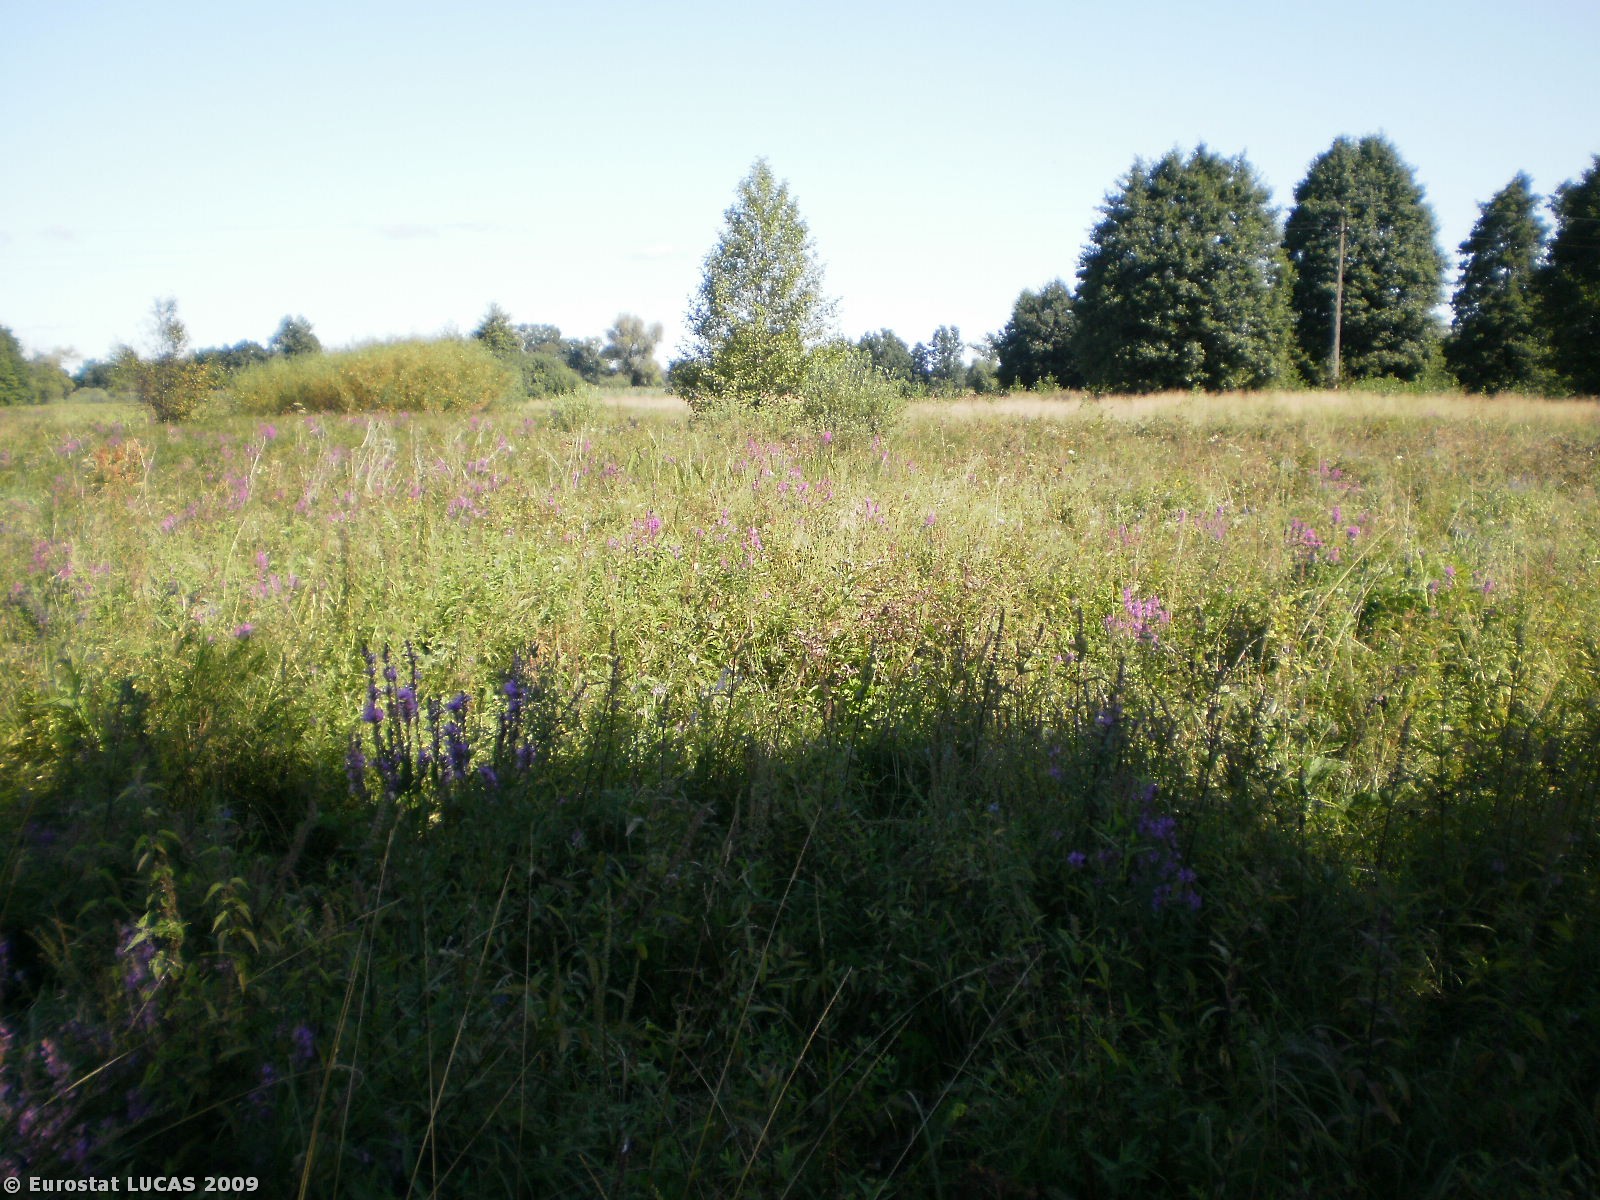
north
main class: Grassland
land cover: Grassland without tree/shrub cover
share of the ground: > 75 %
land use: Unused
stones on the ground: < 10 %
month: August
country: PL
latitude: 52.6018
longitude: 21.6434
